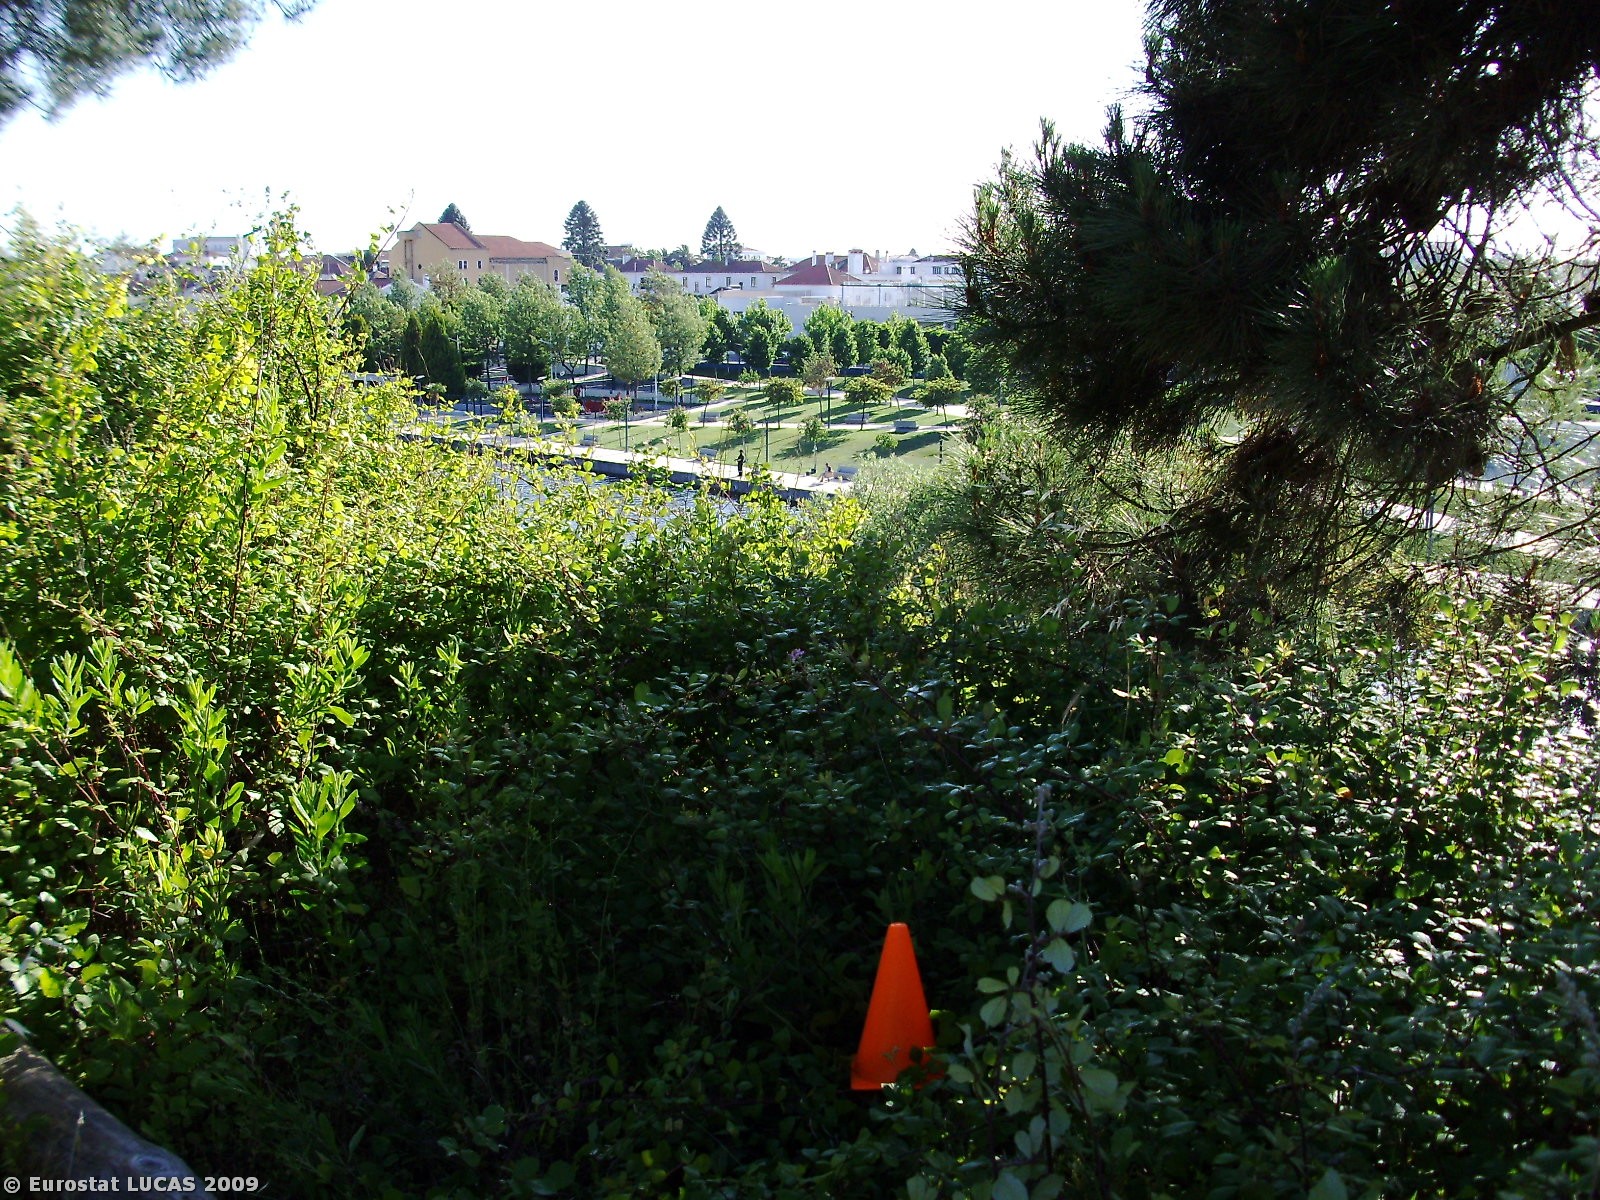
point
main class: Woodland
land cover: Mixed woodland
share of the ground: 25 - 50 %
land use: Forestry
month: May
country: PT
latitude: 39.2516
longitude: -8.0043
